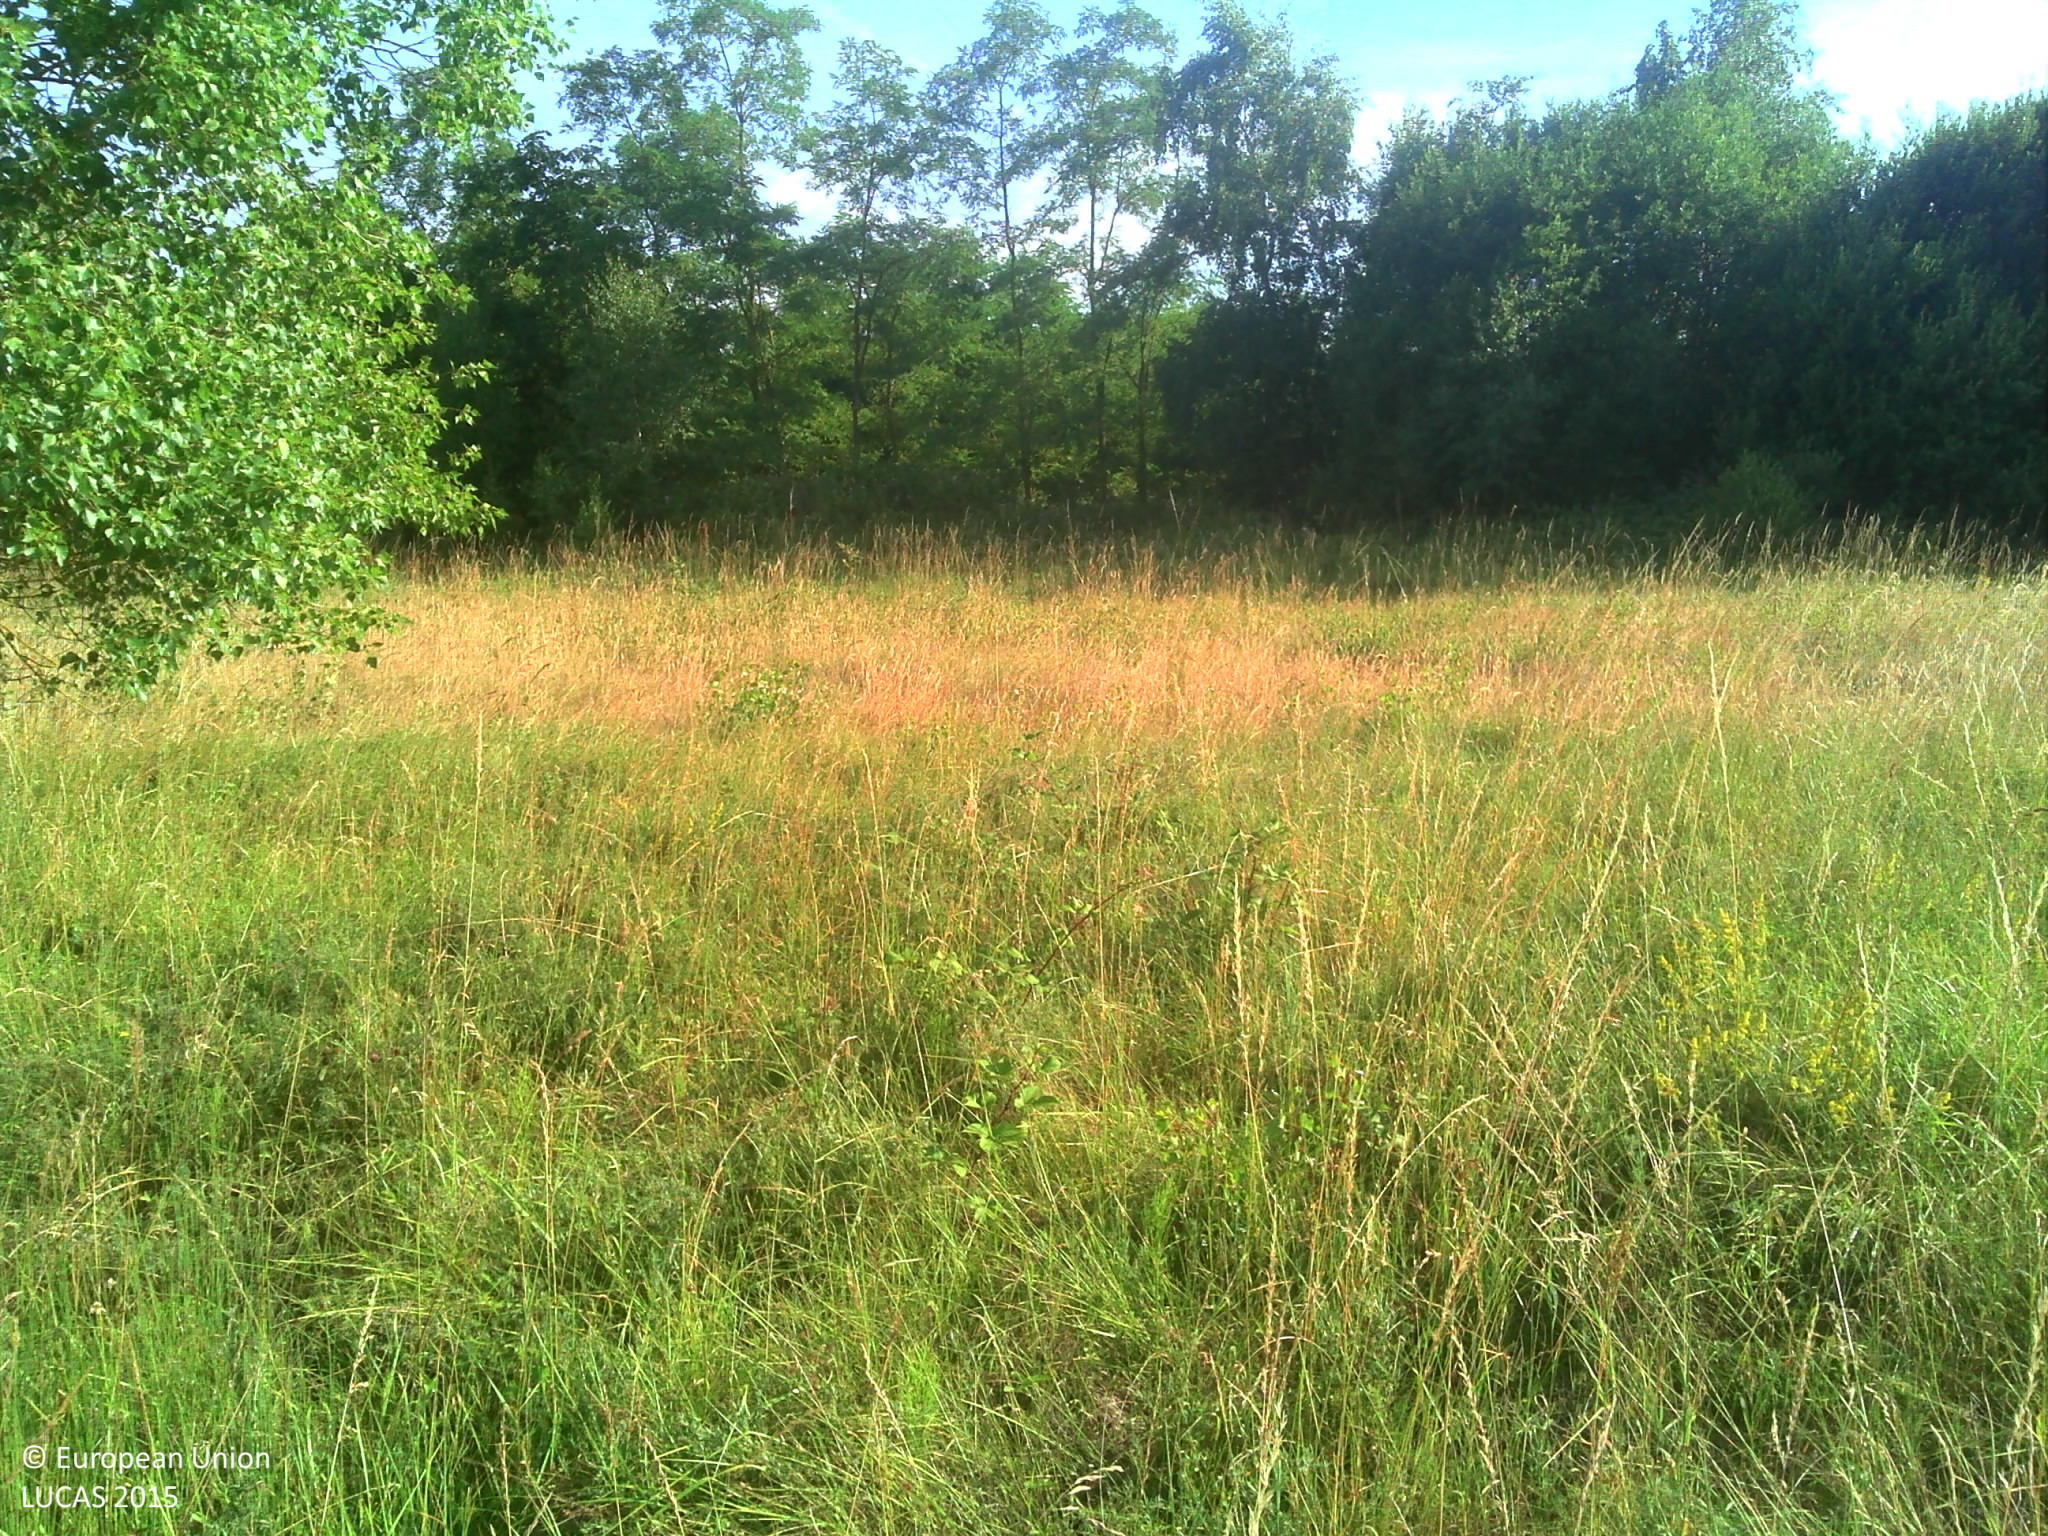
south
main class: Grassland
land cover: Grassland with sparse tree/shrub cover
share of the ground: > 75 %
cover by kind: herbaceous plants 95 %, broadleaved forest trees 5 %
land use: Construction
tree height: > 5 m
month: June
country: FR
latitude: 47.3994
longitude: 1.4132
